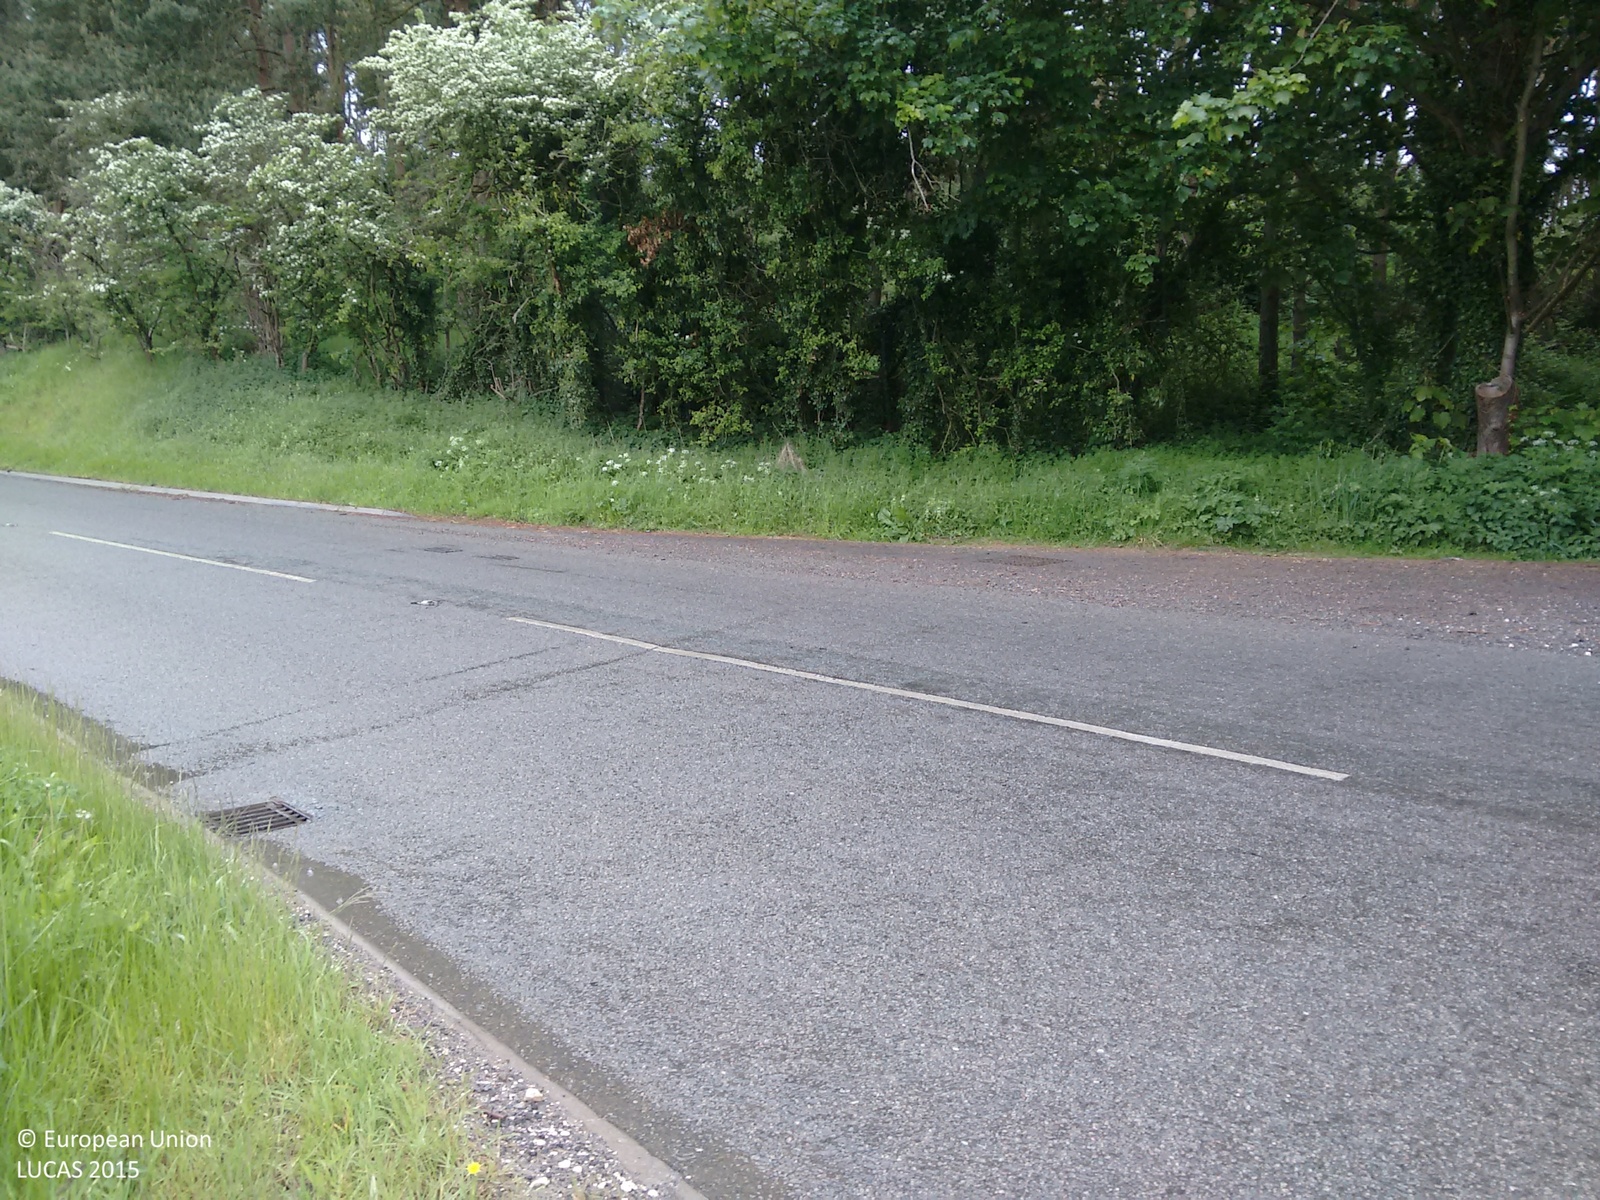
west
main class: Cropland
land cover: Arable land (only in case pi)
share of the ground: > 75 %
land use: Agriculture (excluding fallow land and kitchen gardens)
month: May
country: GB
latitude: 53.4012
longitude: -0.2470
